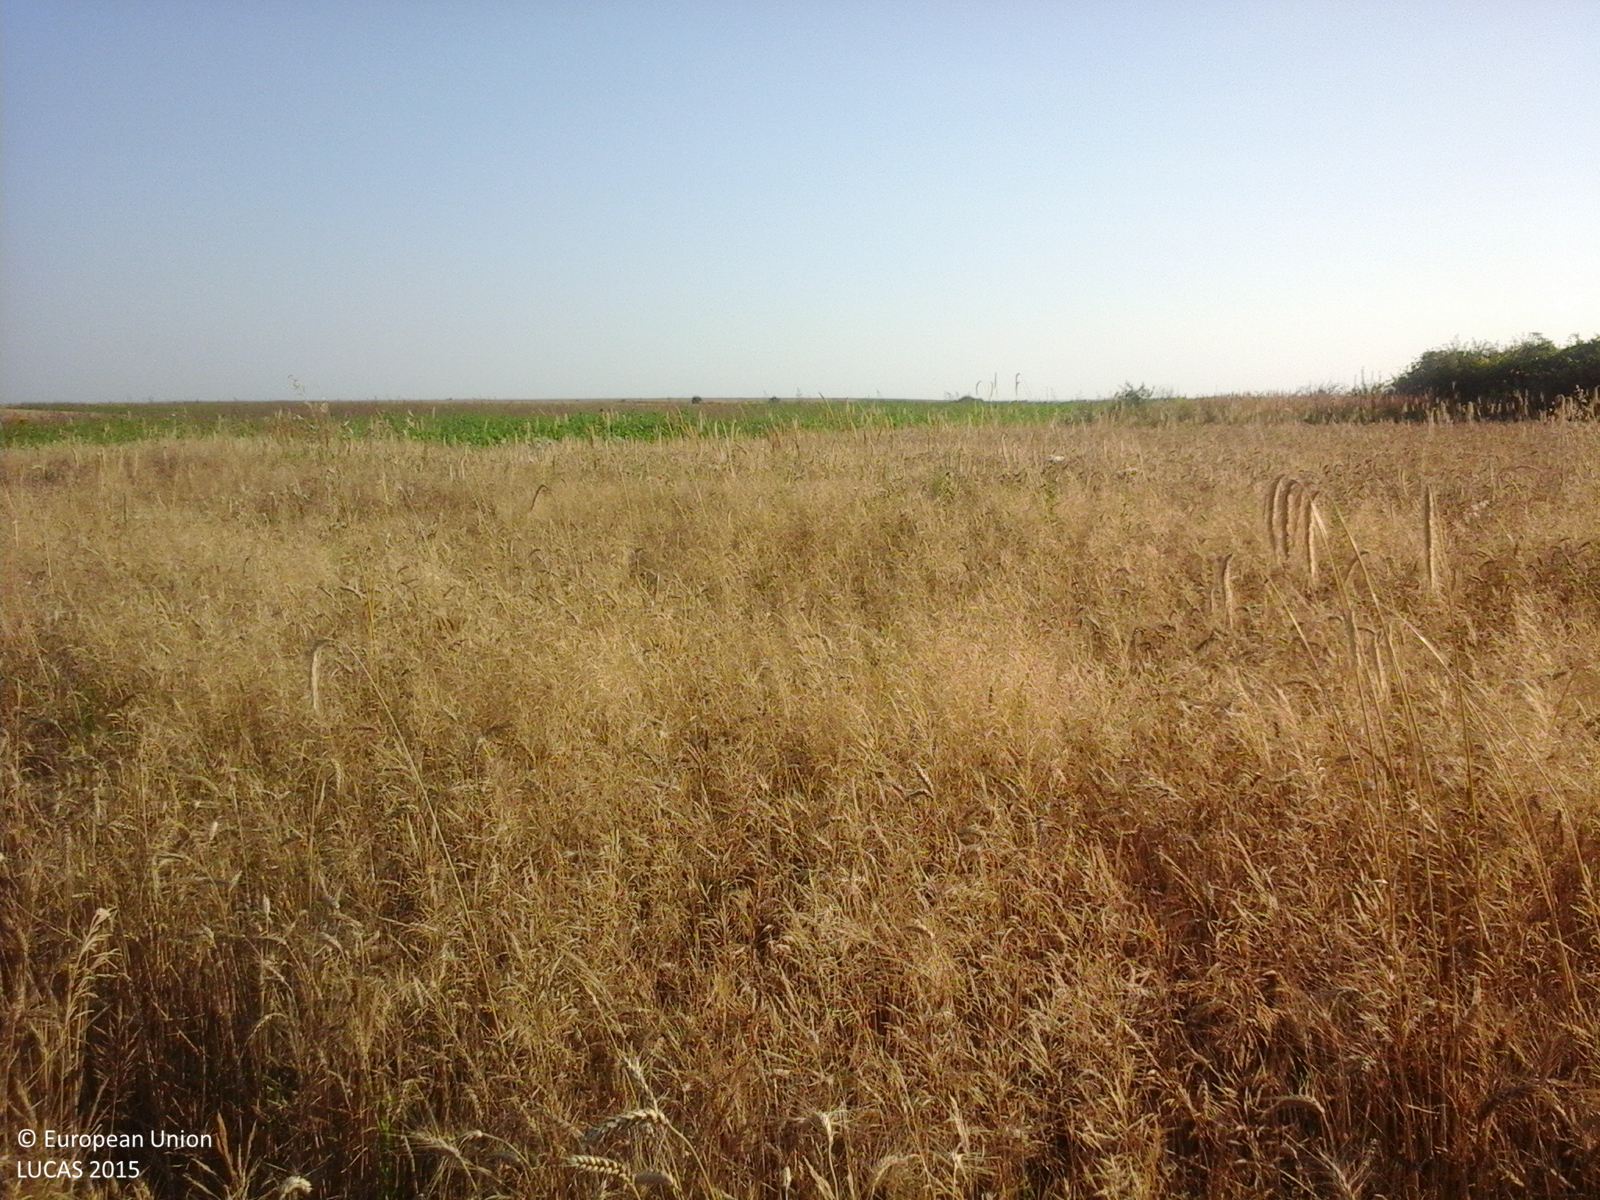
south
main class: Cropland
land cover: Common wheat
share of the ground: > 75 %
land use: Agriculture (excluding fallow land and kitchen gardens)
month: July
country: RO
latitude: 44.2469
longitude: 24.4568
